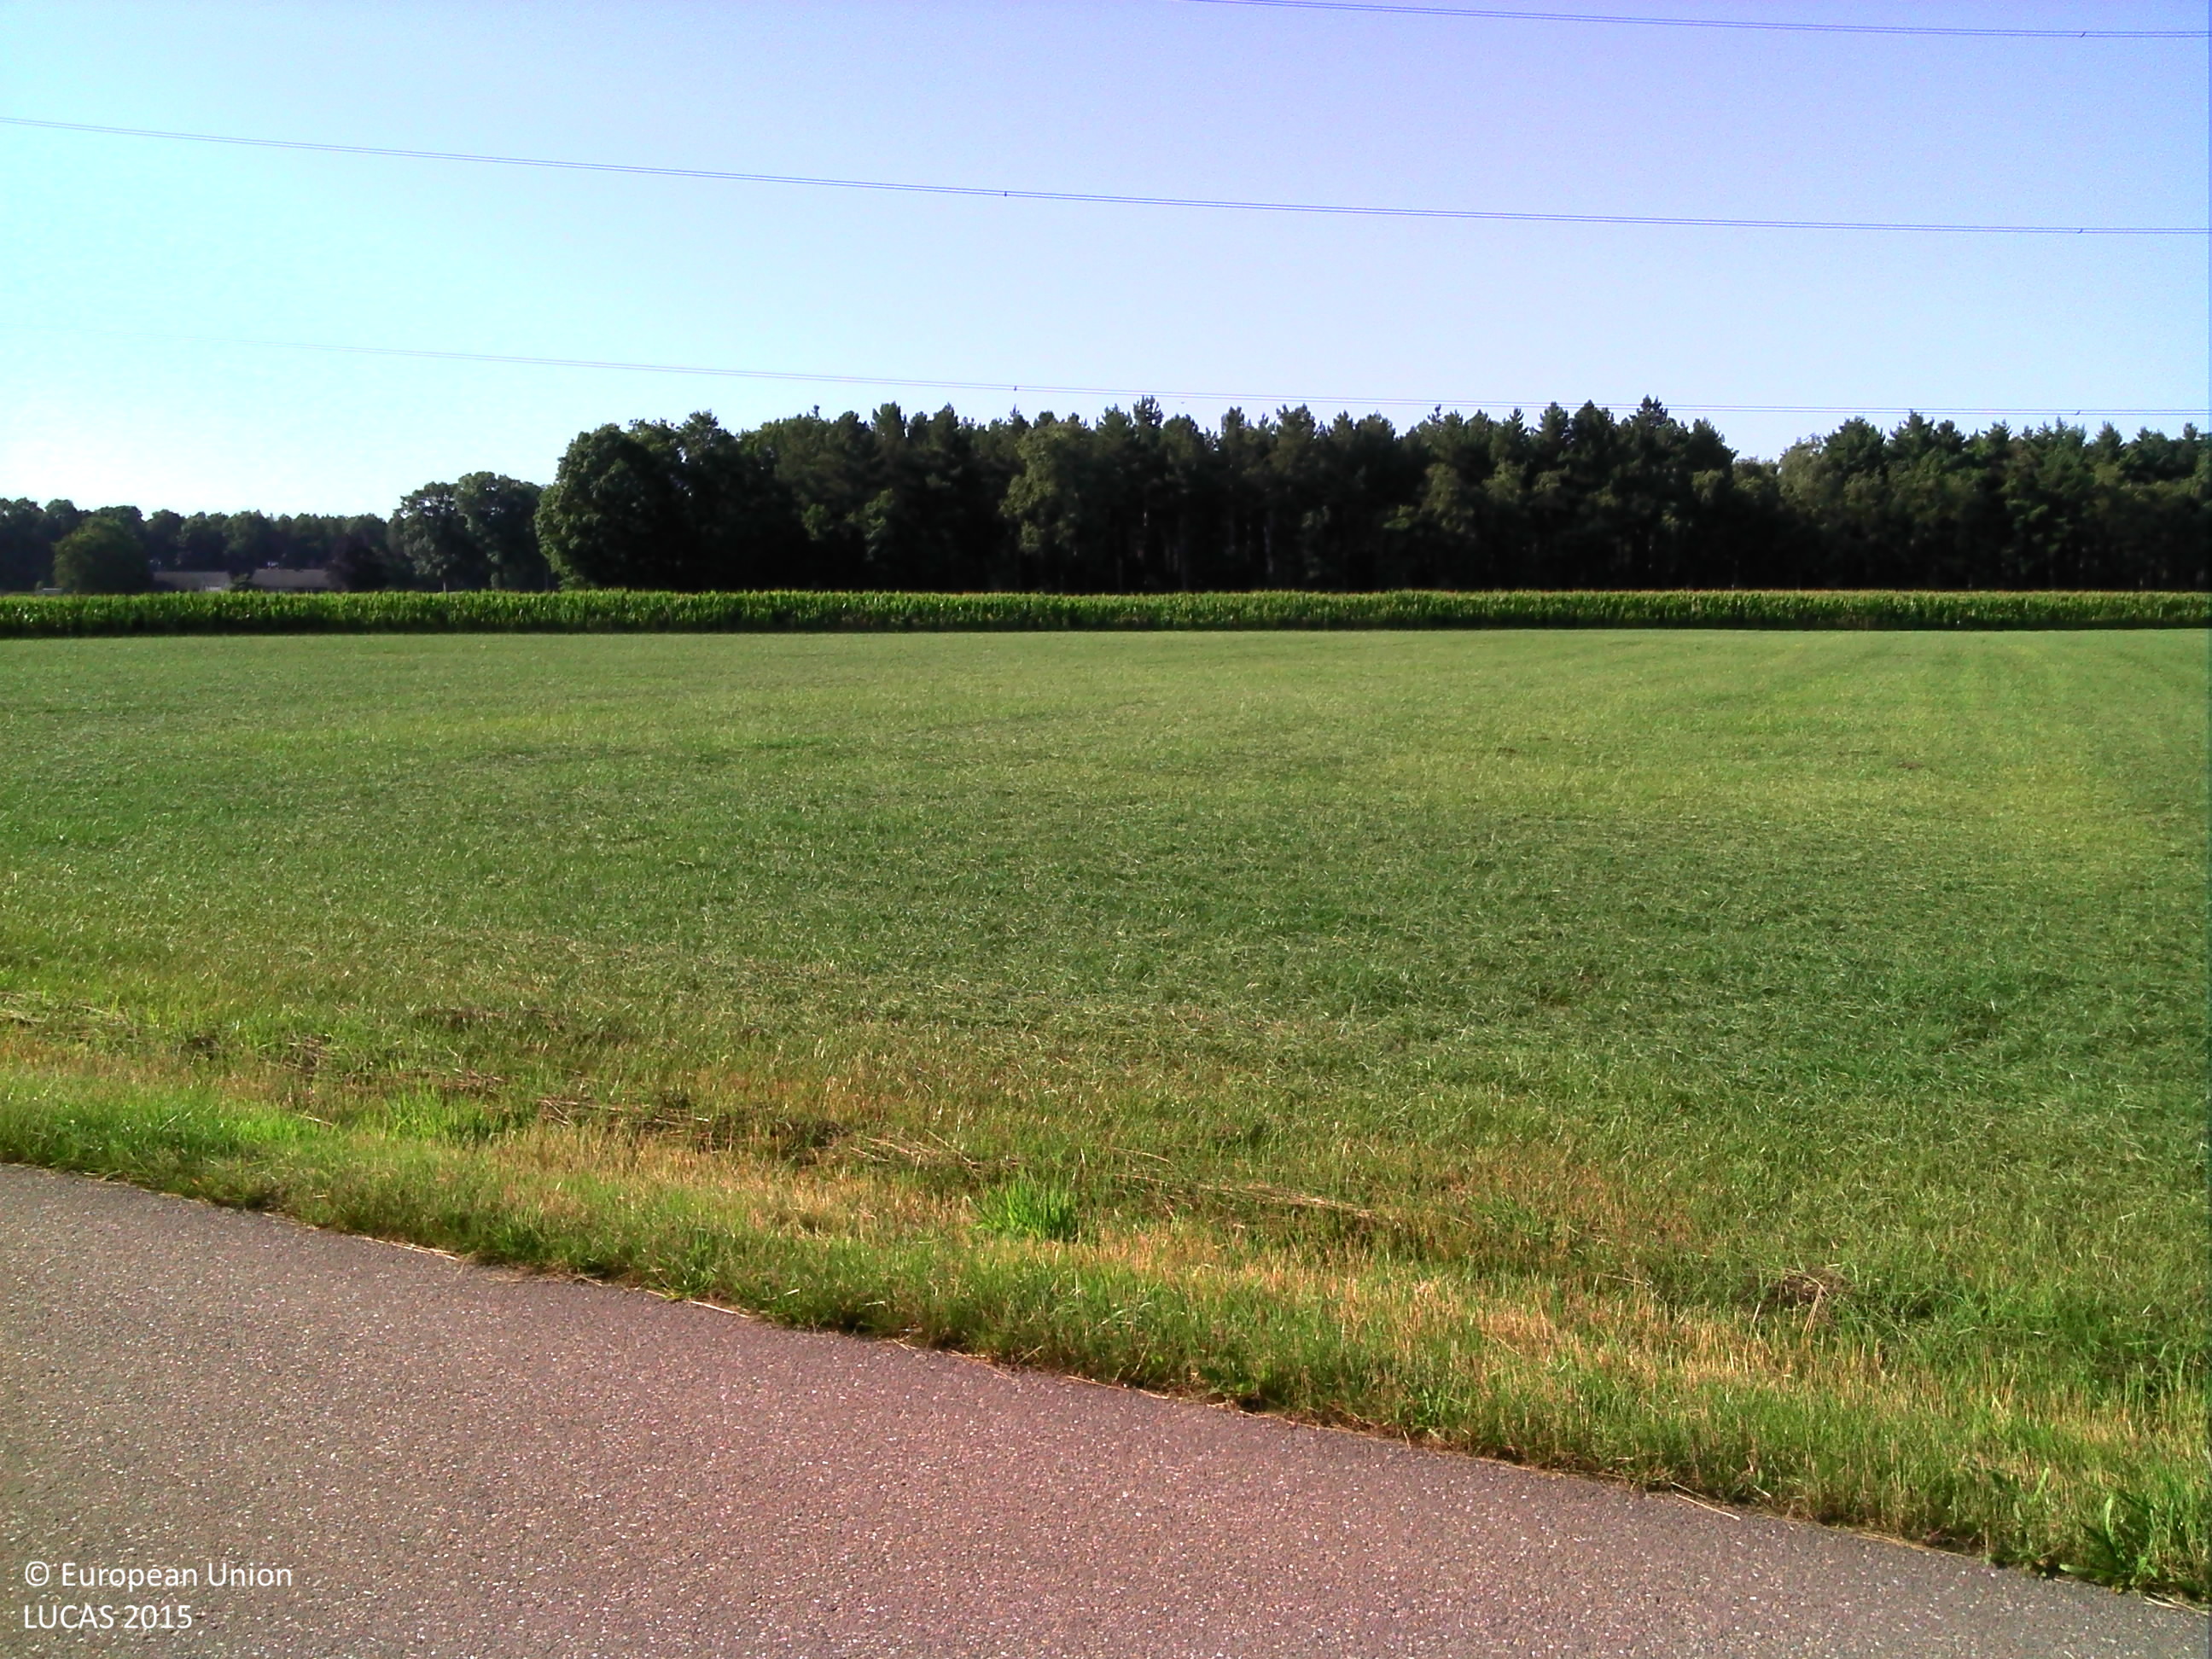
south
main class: Cropland
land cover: Maize
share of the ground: > 75 %
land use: Agriculture (excluding fallow land and kitchen gardens)
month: August
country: BE
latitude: 51.1420
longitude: 5.5530
